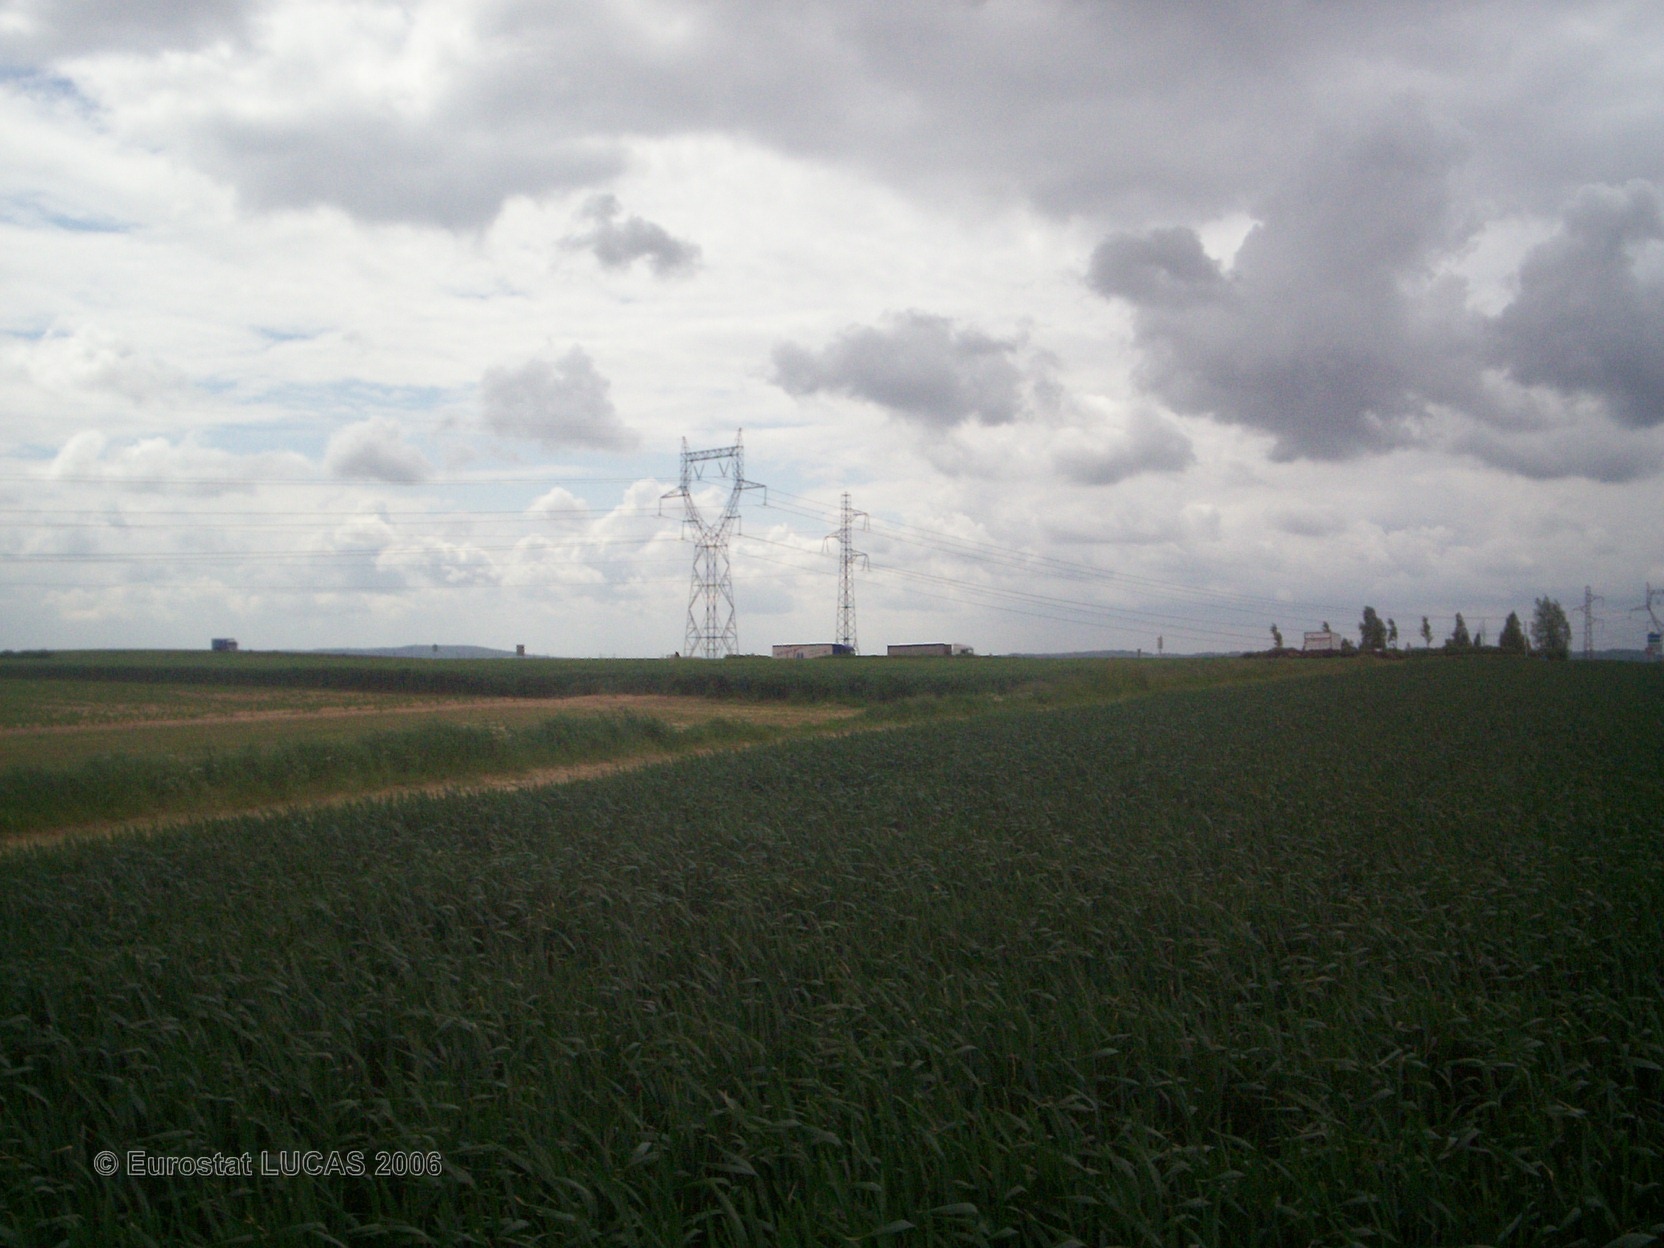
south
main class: Cropland
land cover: Common wheat
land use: Agriculture (excluding fallow land and kitchen gardens)
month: May
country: FR
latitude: 49.1203
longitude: 2.7138
